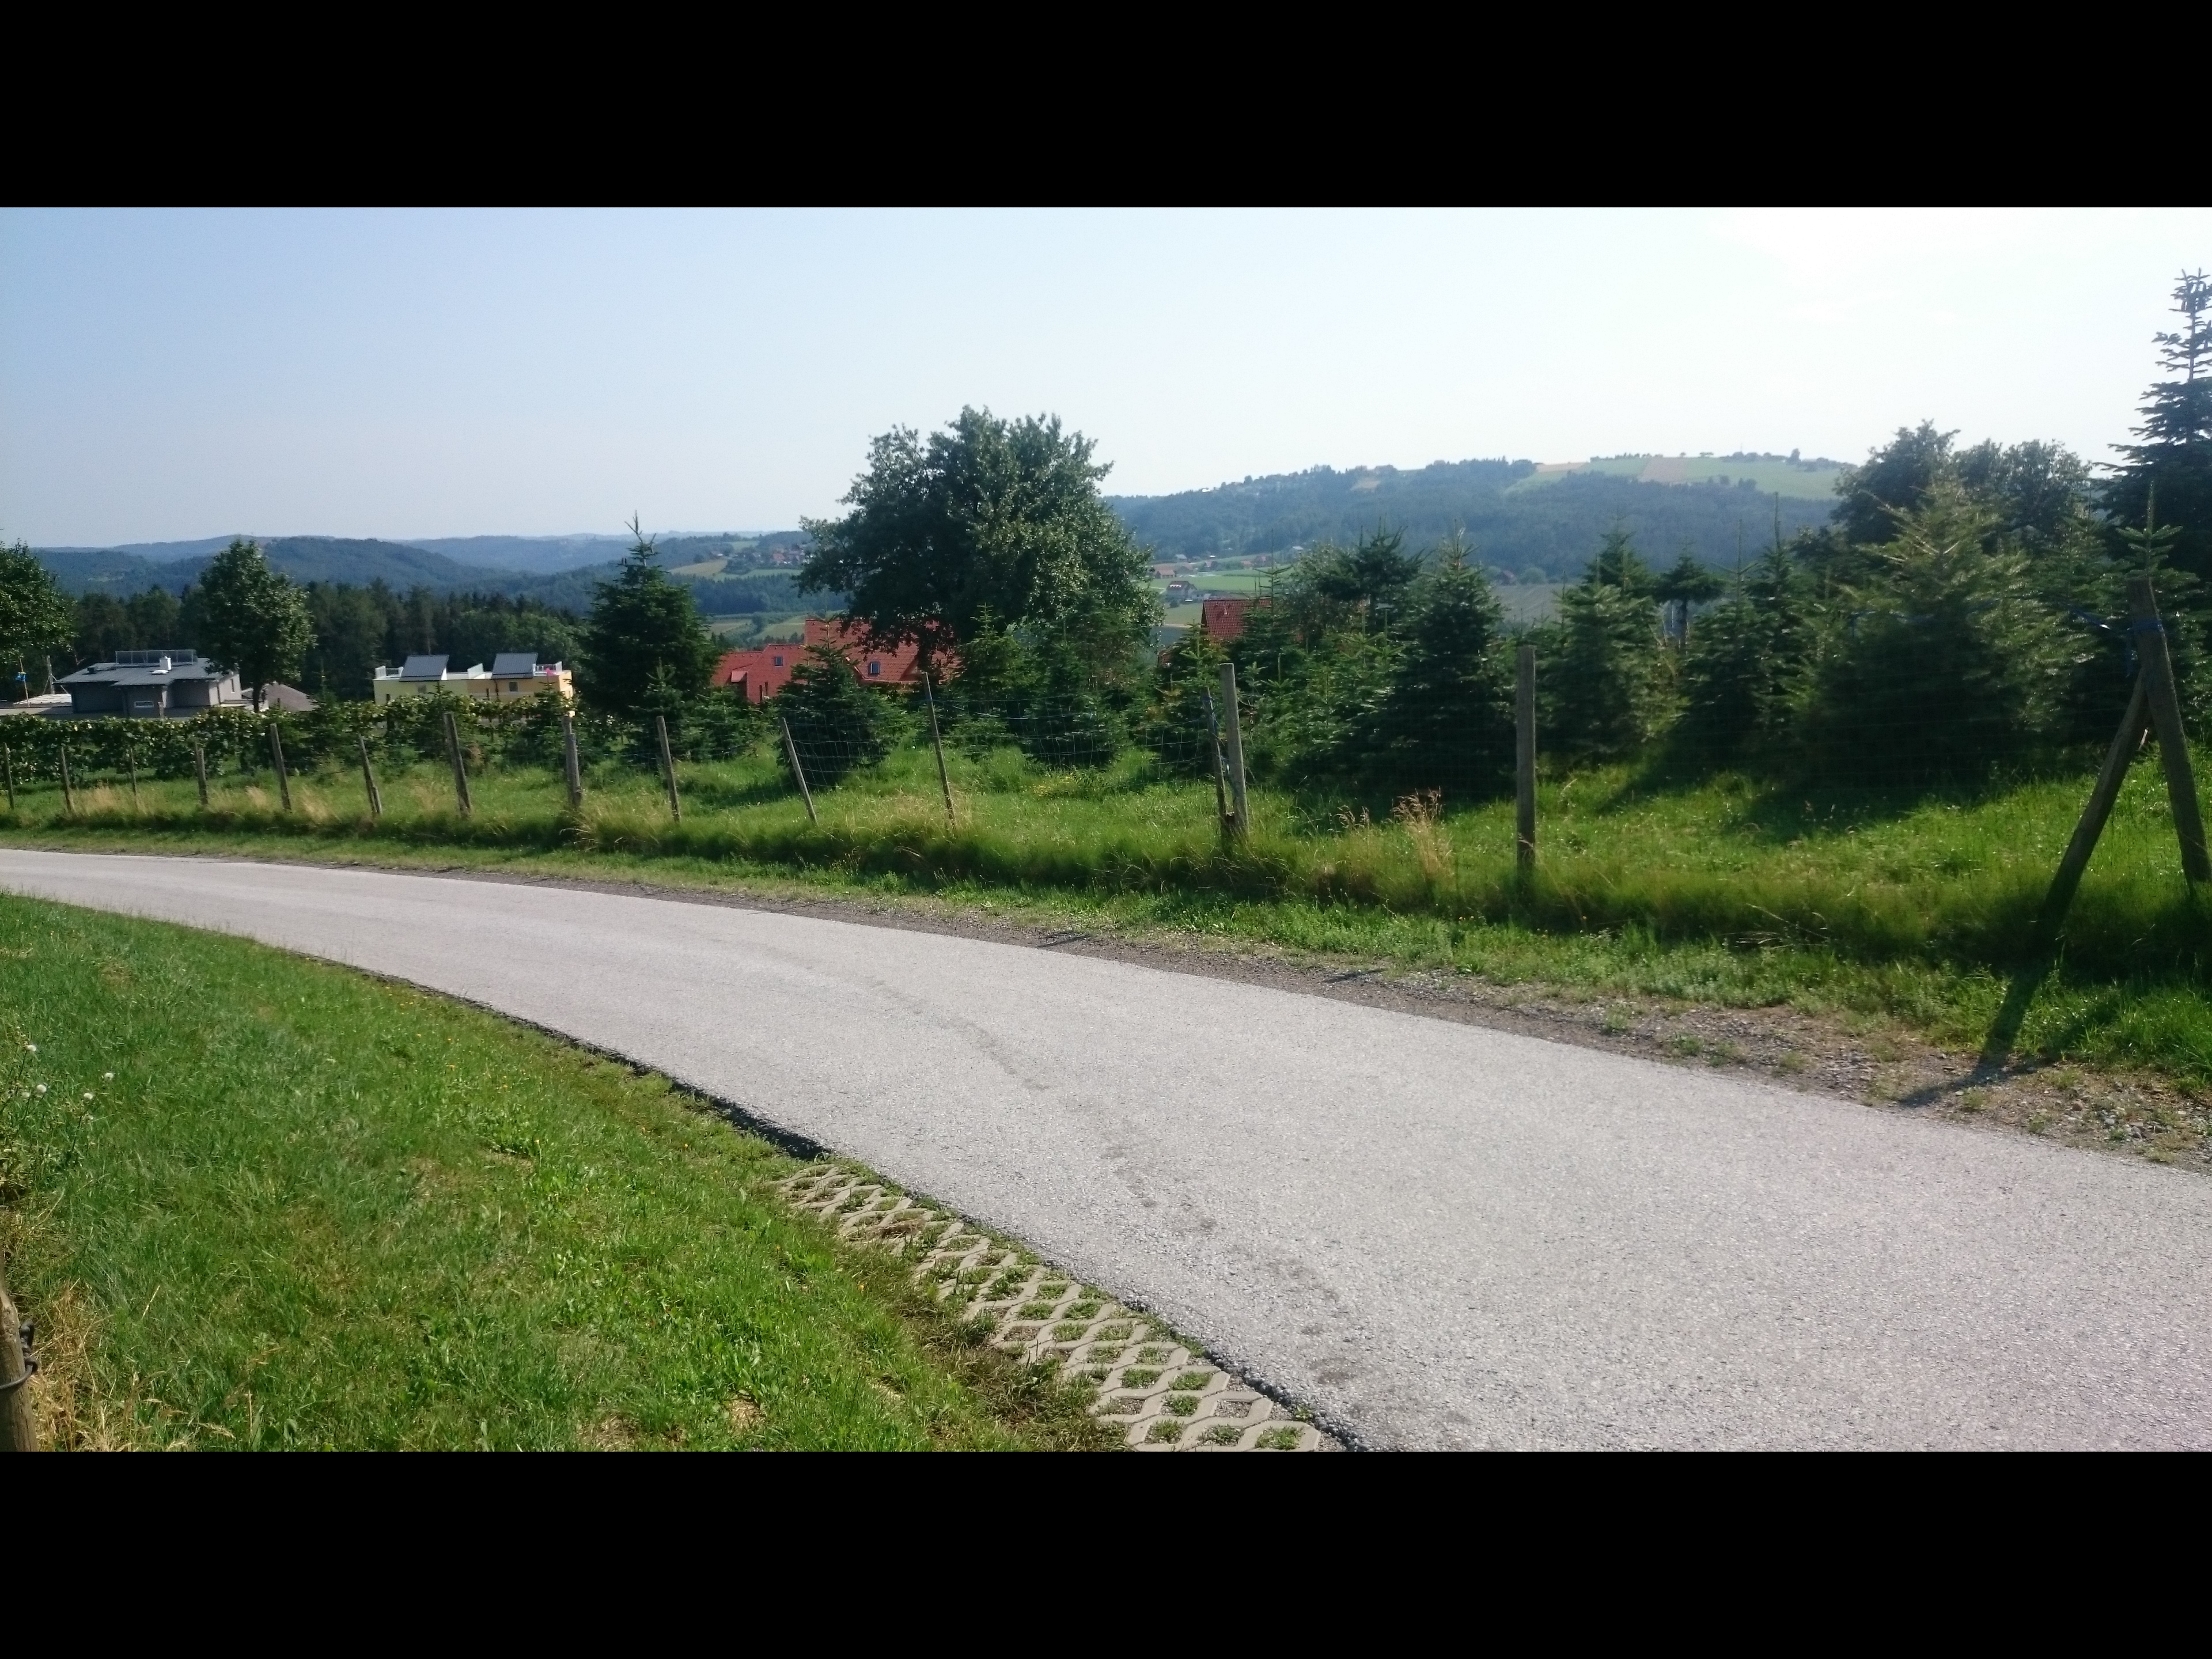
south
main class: Woodland
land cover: Other coniferous woodland
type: hemiboreal forest and nemoral coniferous forest and mixed broadleaved-coniferous forest
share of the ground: 50 - 75 %
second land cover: Grassland without tree/shrub cover
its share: 25 - 50 %
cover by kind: coniferous forest trees 55 %, herbaceous plants 45 %
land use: Forestry
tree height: < 5 m
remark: Nursery
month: July
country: AT
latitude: 47.2146
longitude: 15.6122
